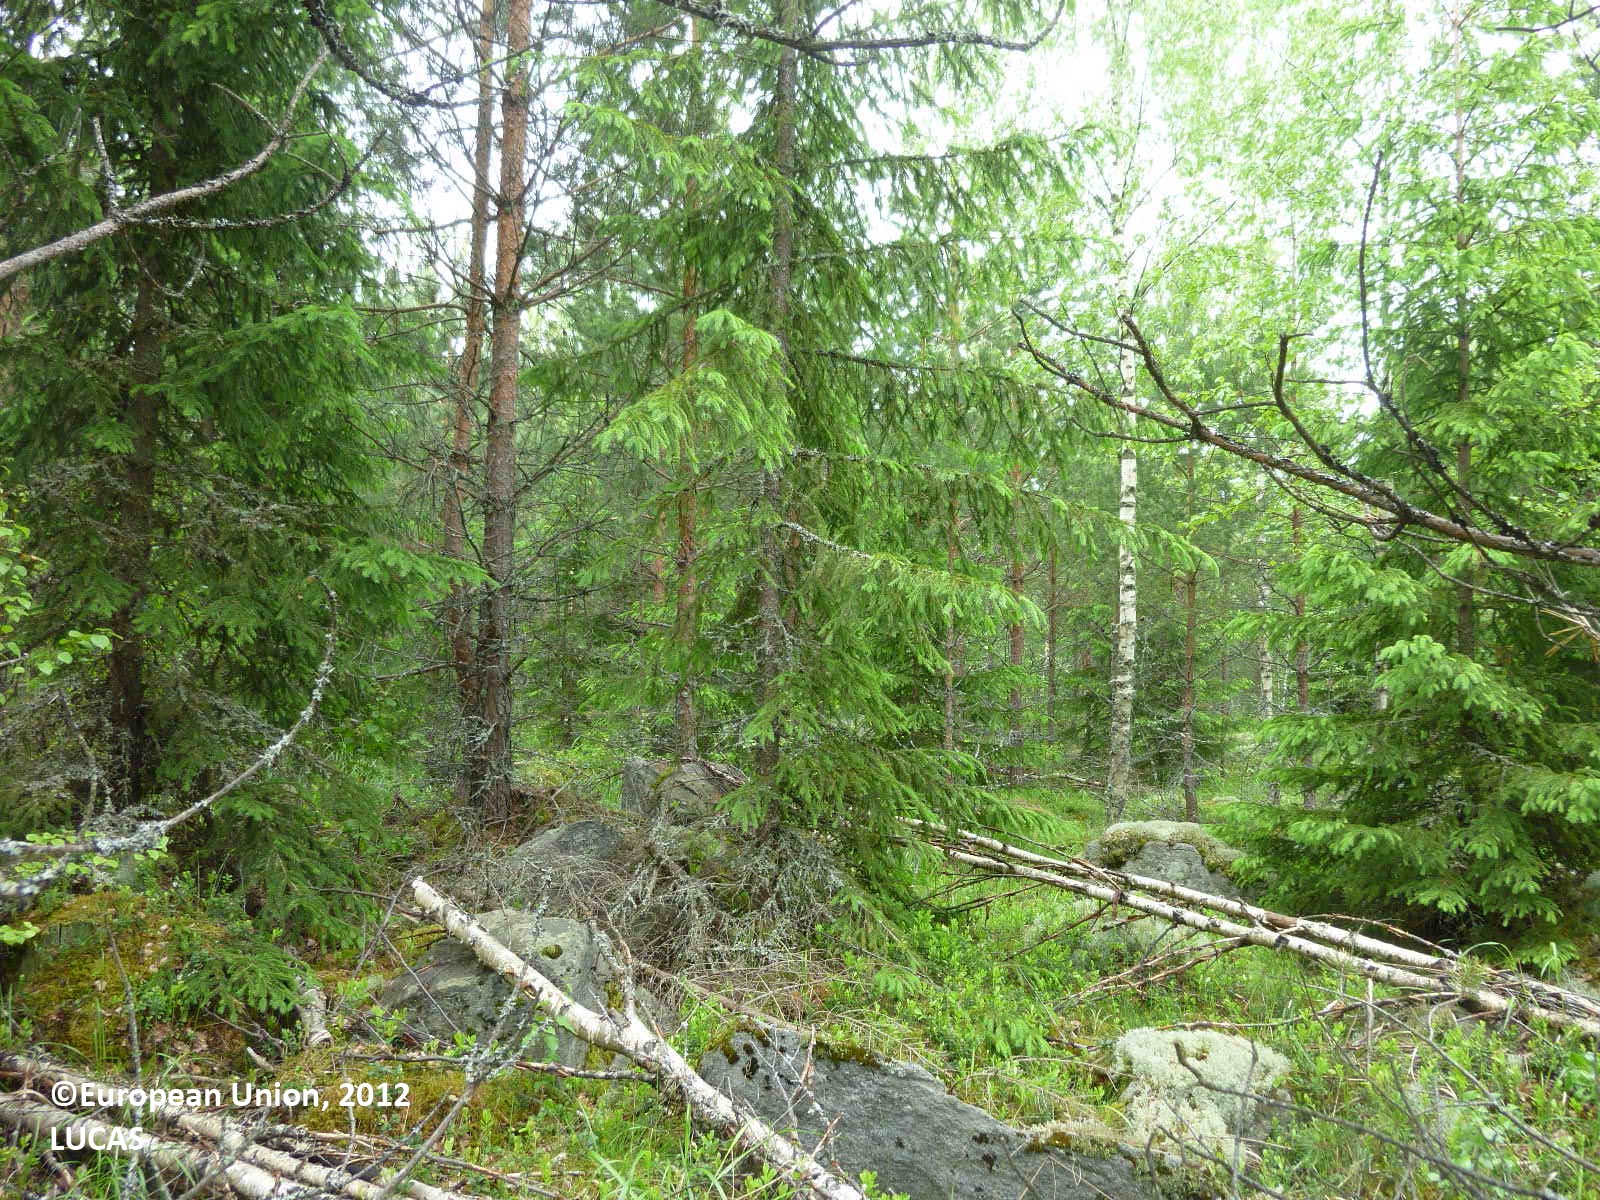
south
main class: Woodland
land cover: Other coniferous woodland
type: boreal forest
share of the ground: 50 - 75 %
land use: Forestry
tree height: > 5 m
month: June
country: FI
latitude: 61.5426
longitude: 22.0404
